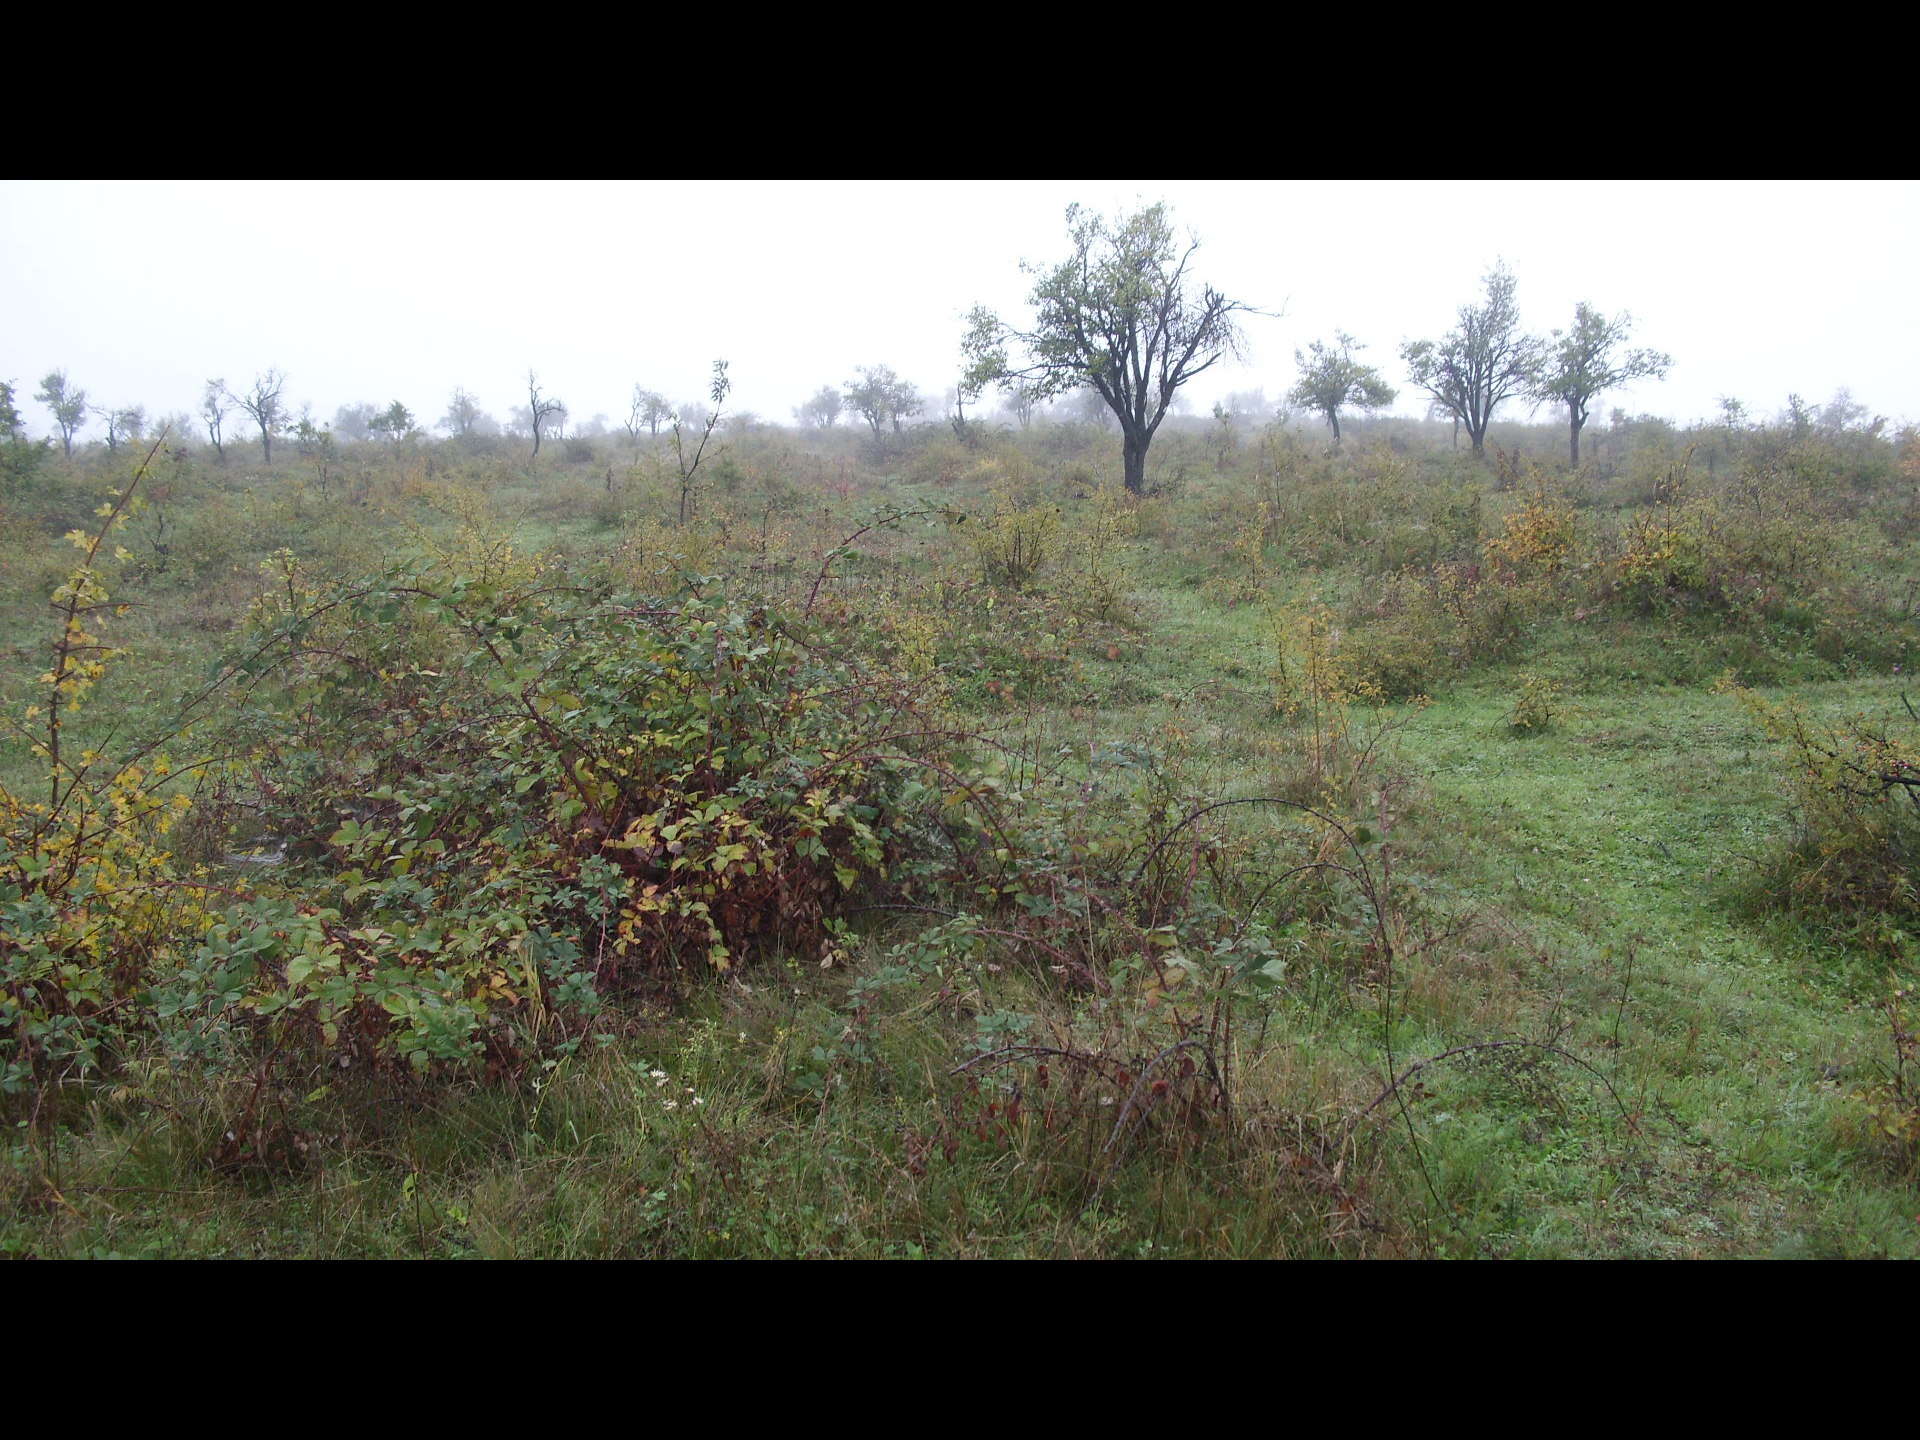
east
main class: Cropland
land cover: Other fruit trees and berries
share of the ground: < 10 %
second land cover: Grassland without tree/shrub cover
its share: > 75 %
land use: Agriculture (excluding fallow land and kitchen gardens)
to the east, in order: Other fruit trees and berries; Grassland without tree/shrub cover; Tracks; Other fruit trees and berries
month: October
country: BG
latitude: 43.7775
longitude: 22.4692
